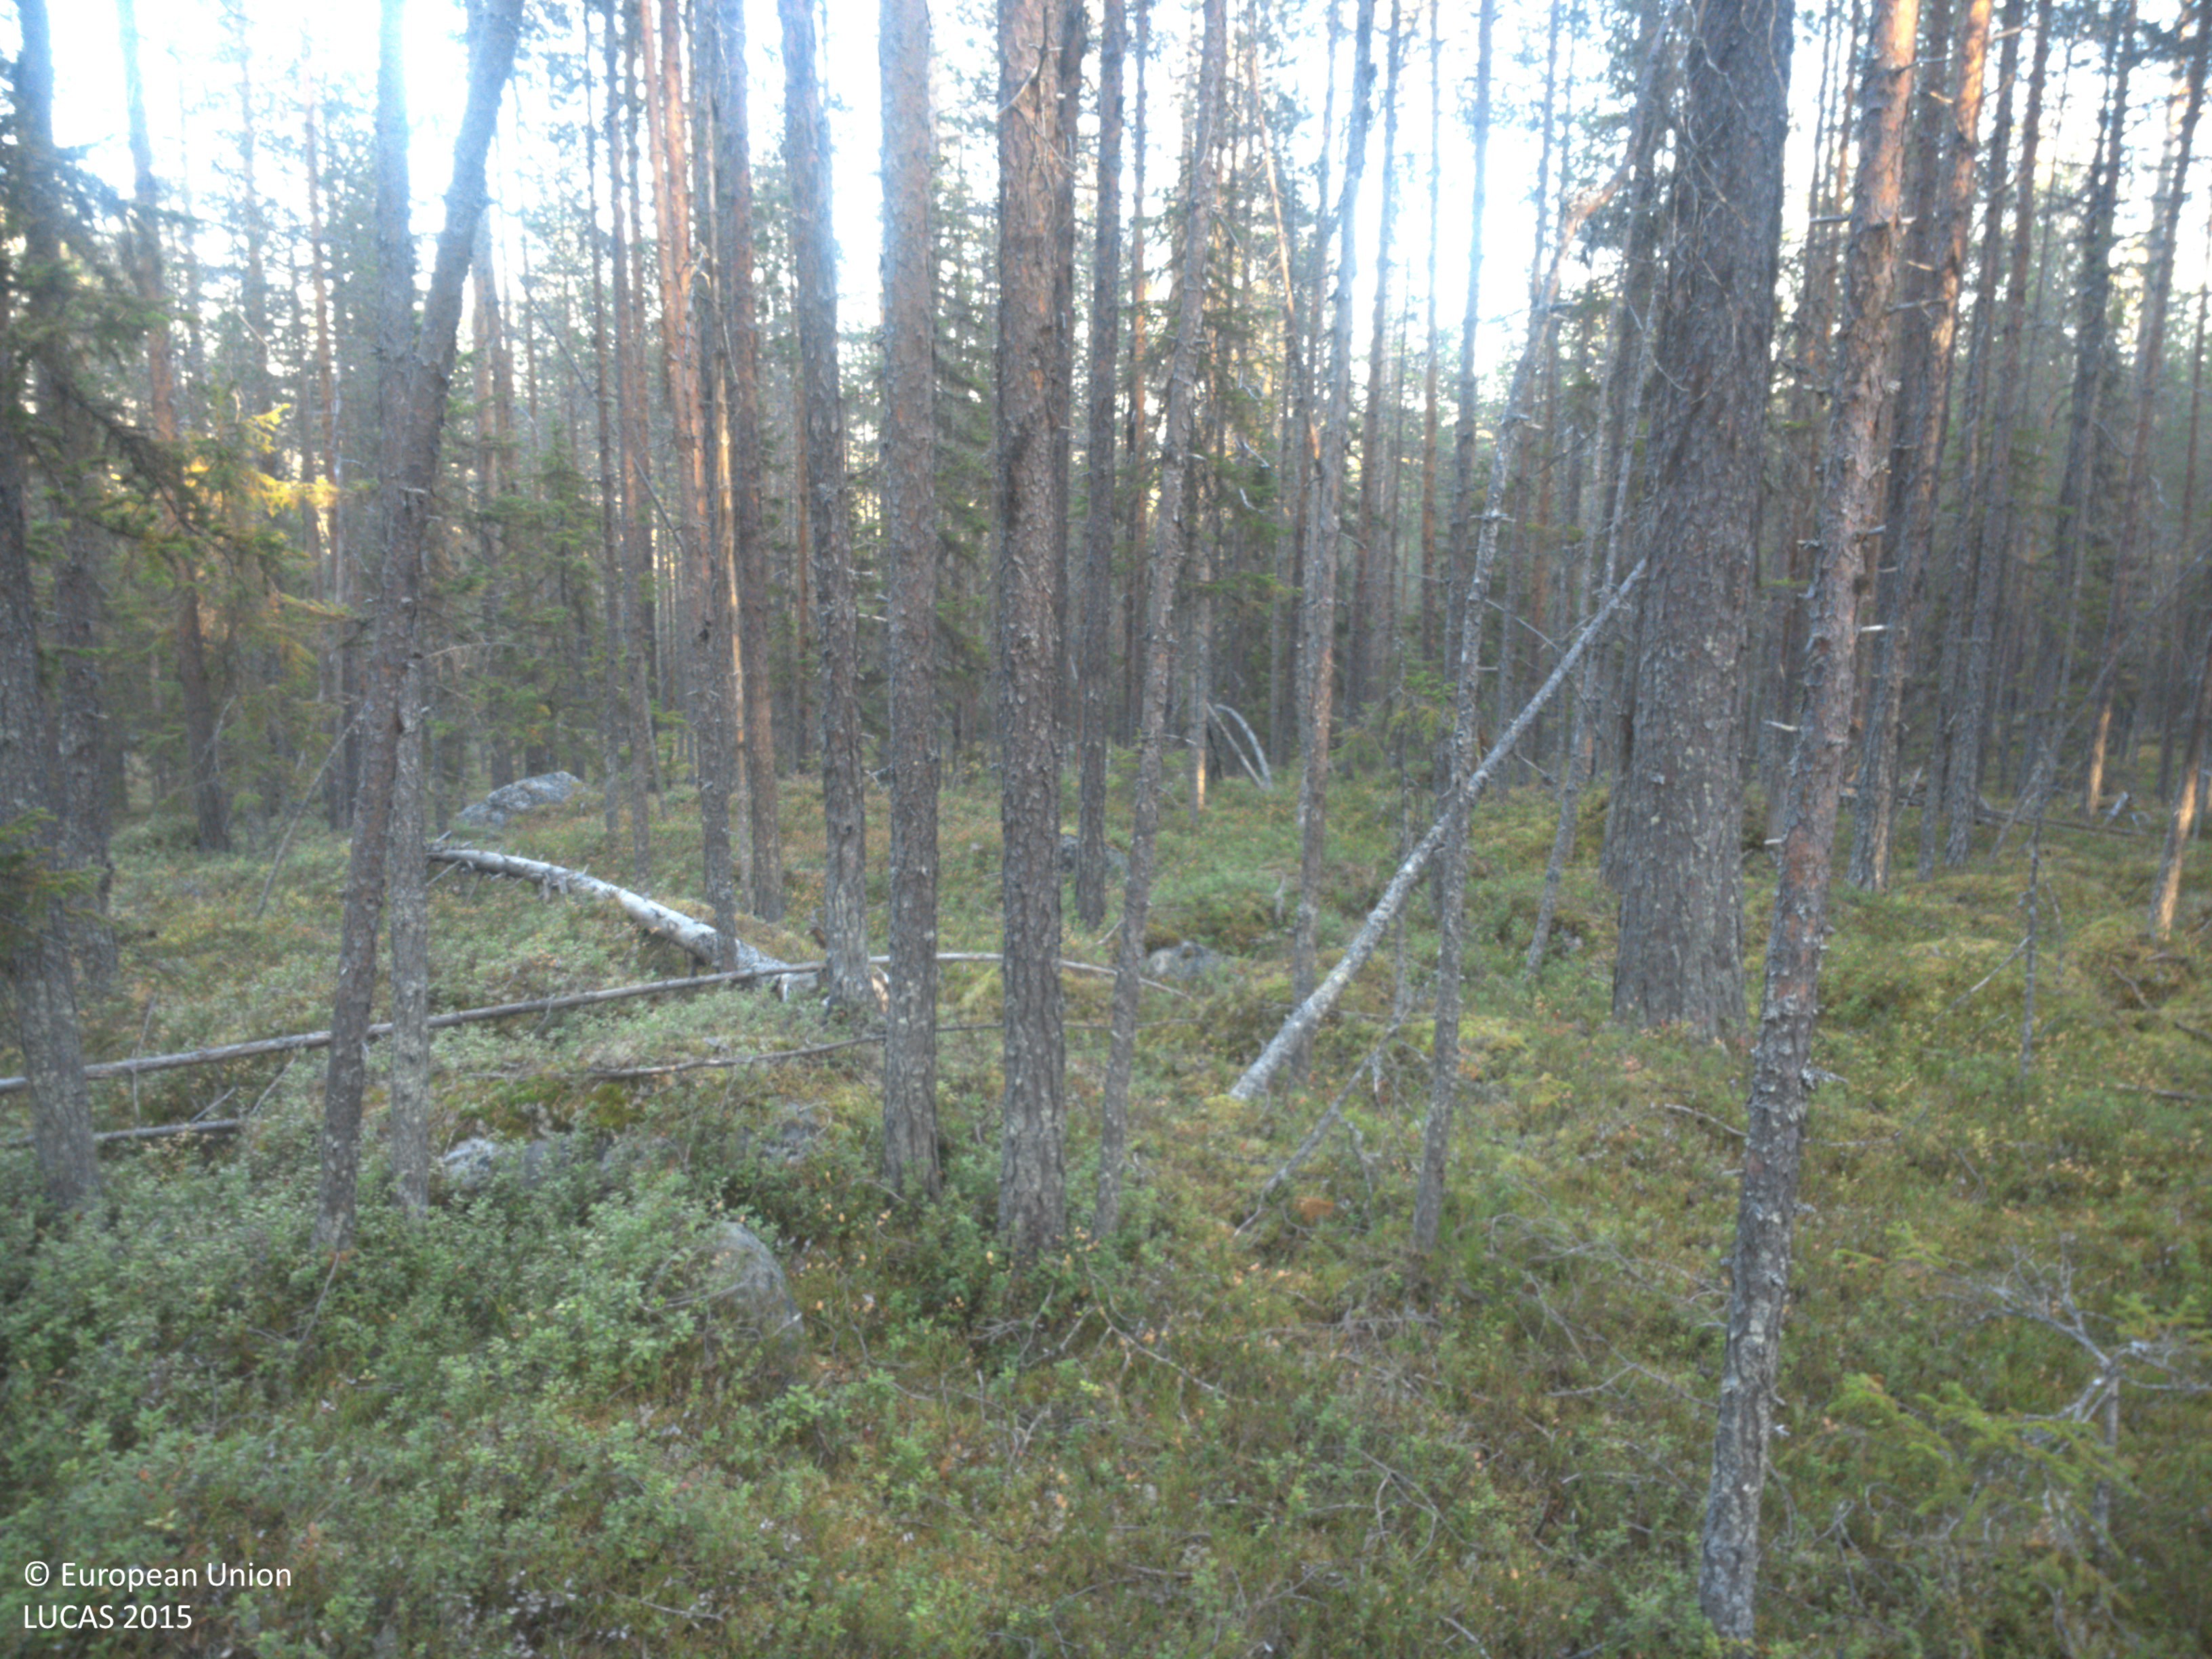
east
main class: Woodland
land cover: Pine dominated coniferous woodland
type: boreal forest
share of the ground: 50 - 75 %
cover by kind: coniferous forest trees 70 %, shrubs 25 %, lichens and mosses 5 %
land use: Forestry
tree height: > 5 m
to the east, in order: Pine dominated coniferous woodland; Spruce dominated coniferous woodland; Pine dominated coniferous woodland
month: October
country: SE
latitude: 64.8599
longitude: 18.1714
